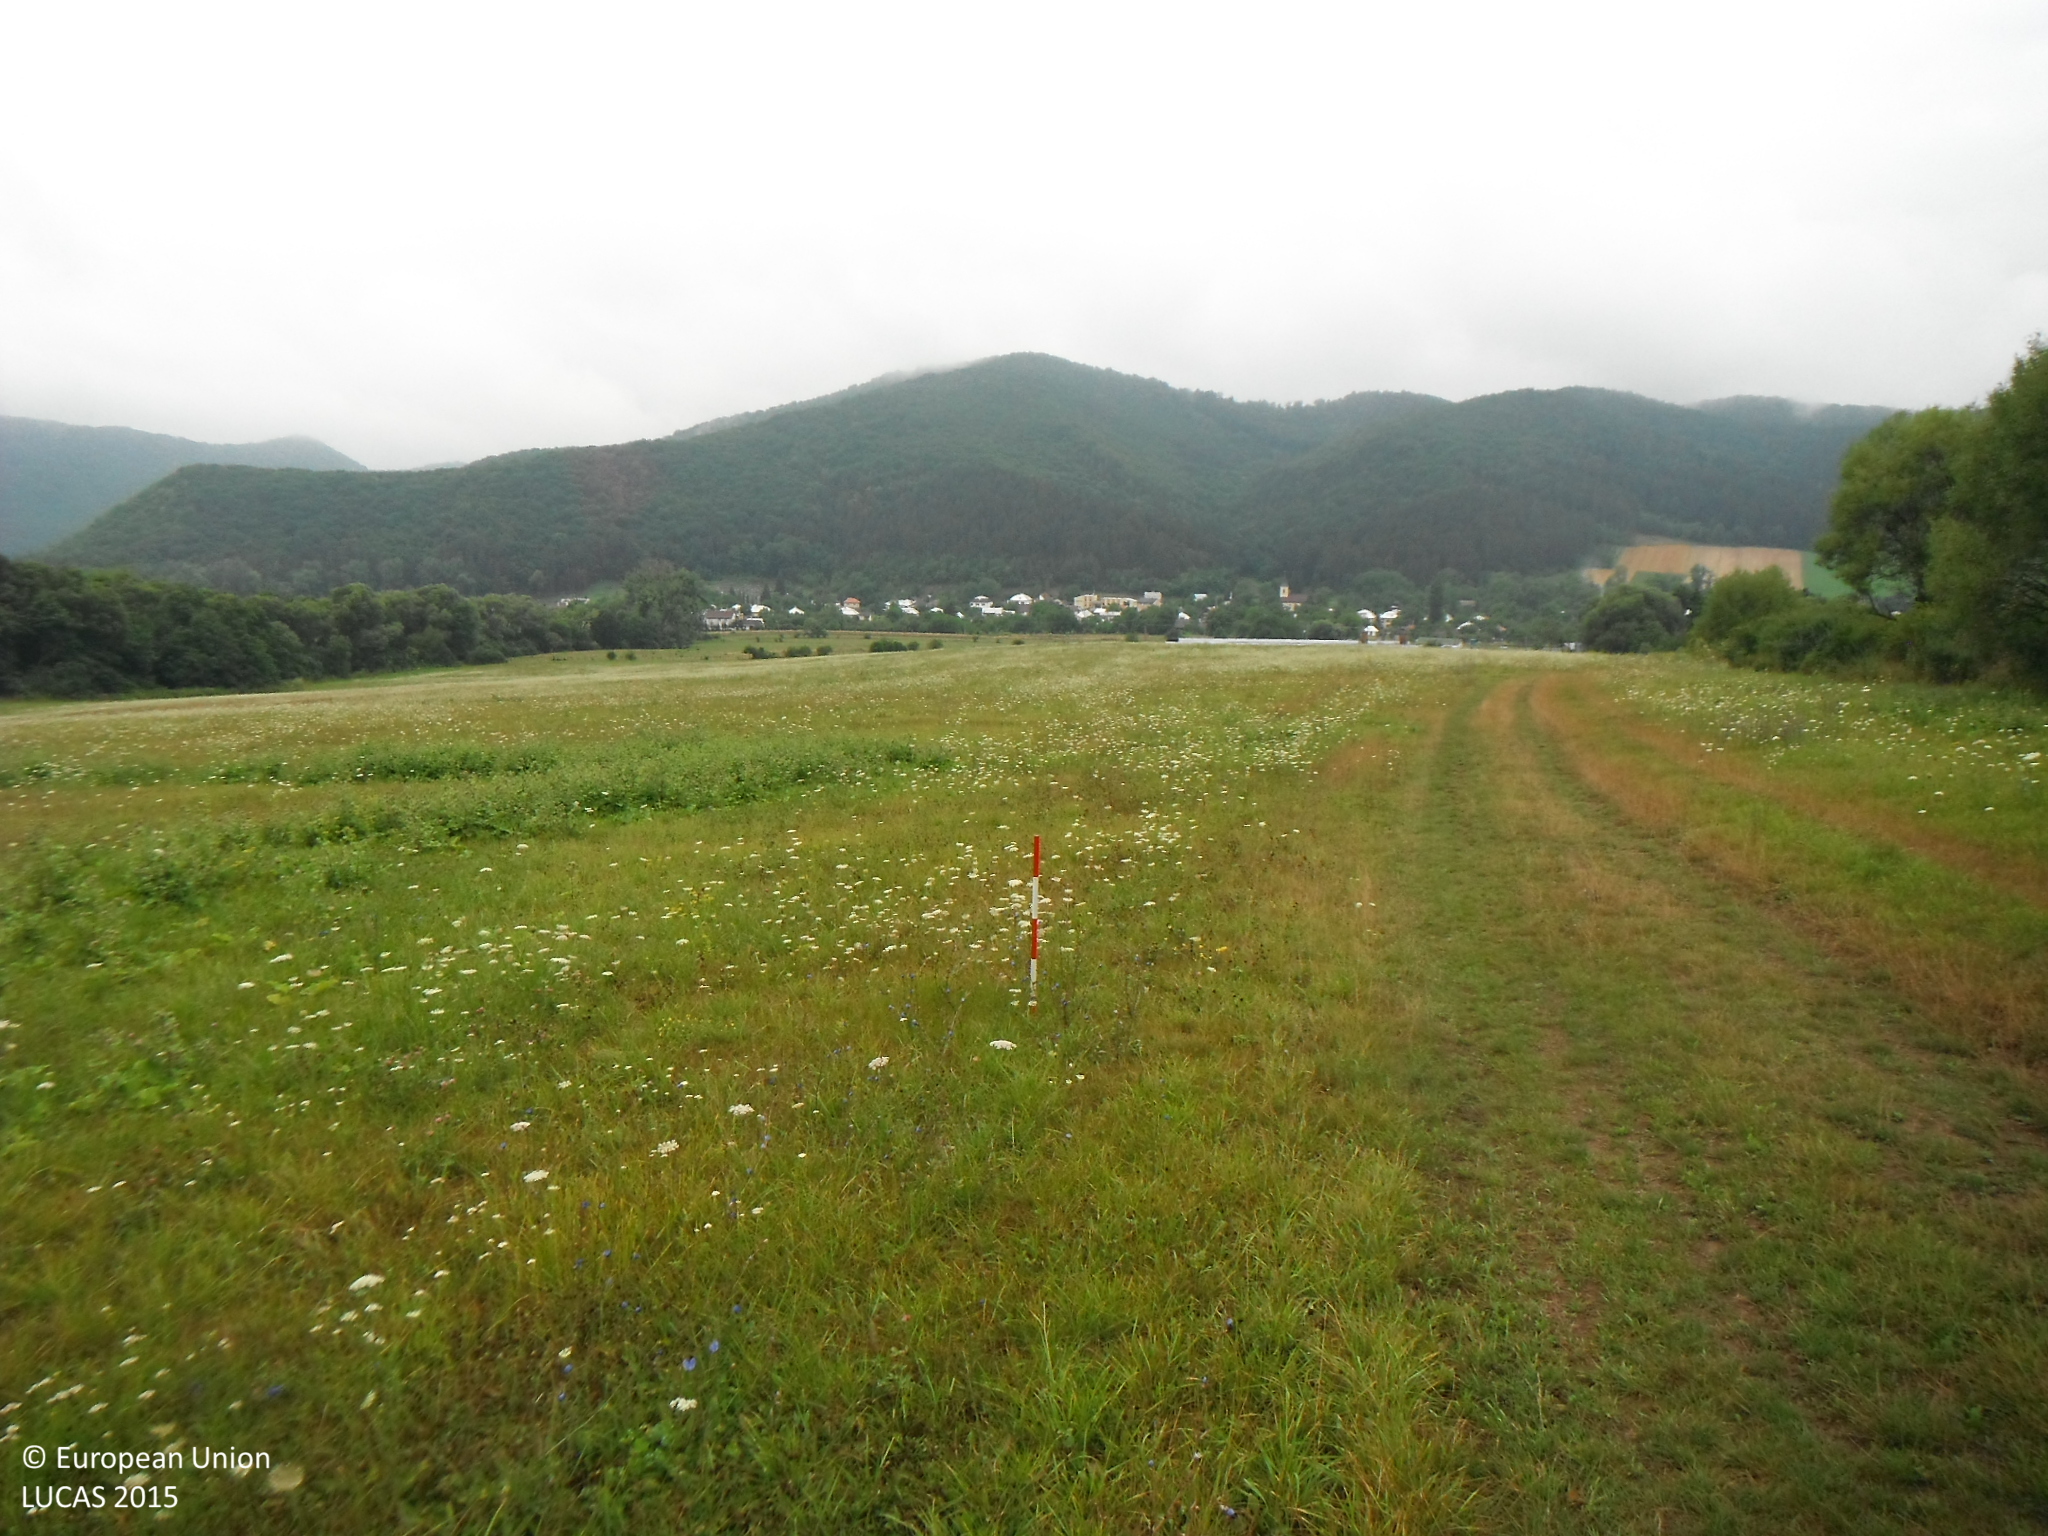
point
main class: Grassland
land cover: Grassland without tree/shrub cover
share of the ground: > 75 %
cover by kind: herbaceous plants 100 %
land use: Agriculture (excluding fallow land and kitchen gardens)
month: July
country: SK
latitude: 48.8971
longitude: 21.9630
